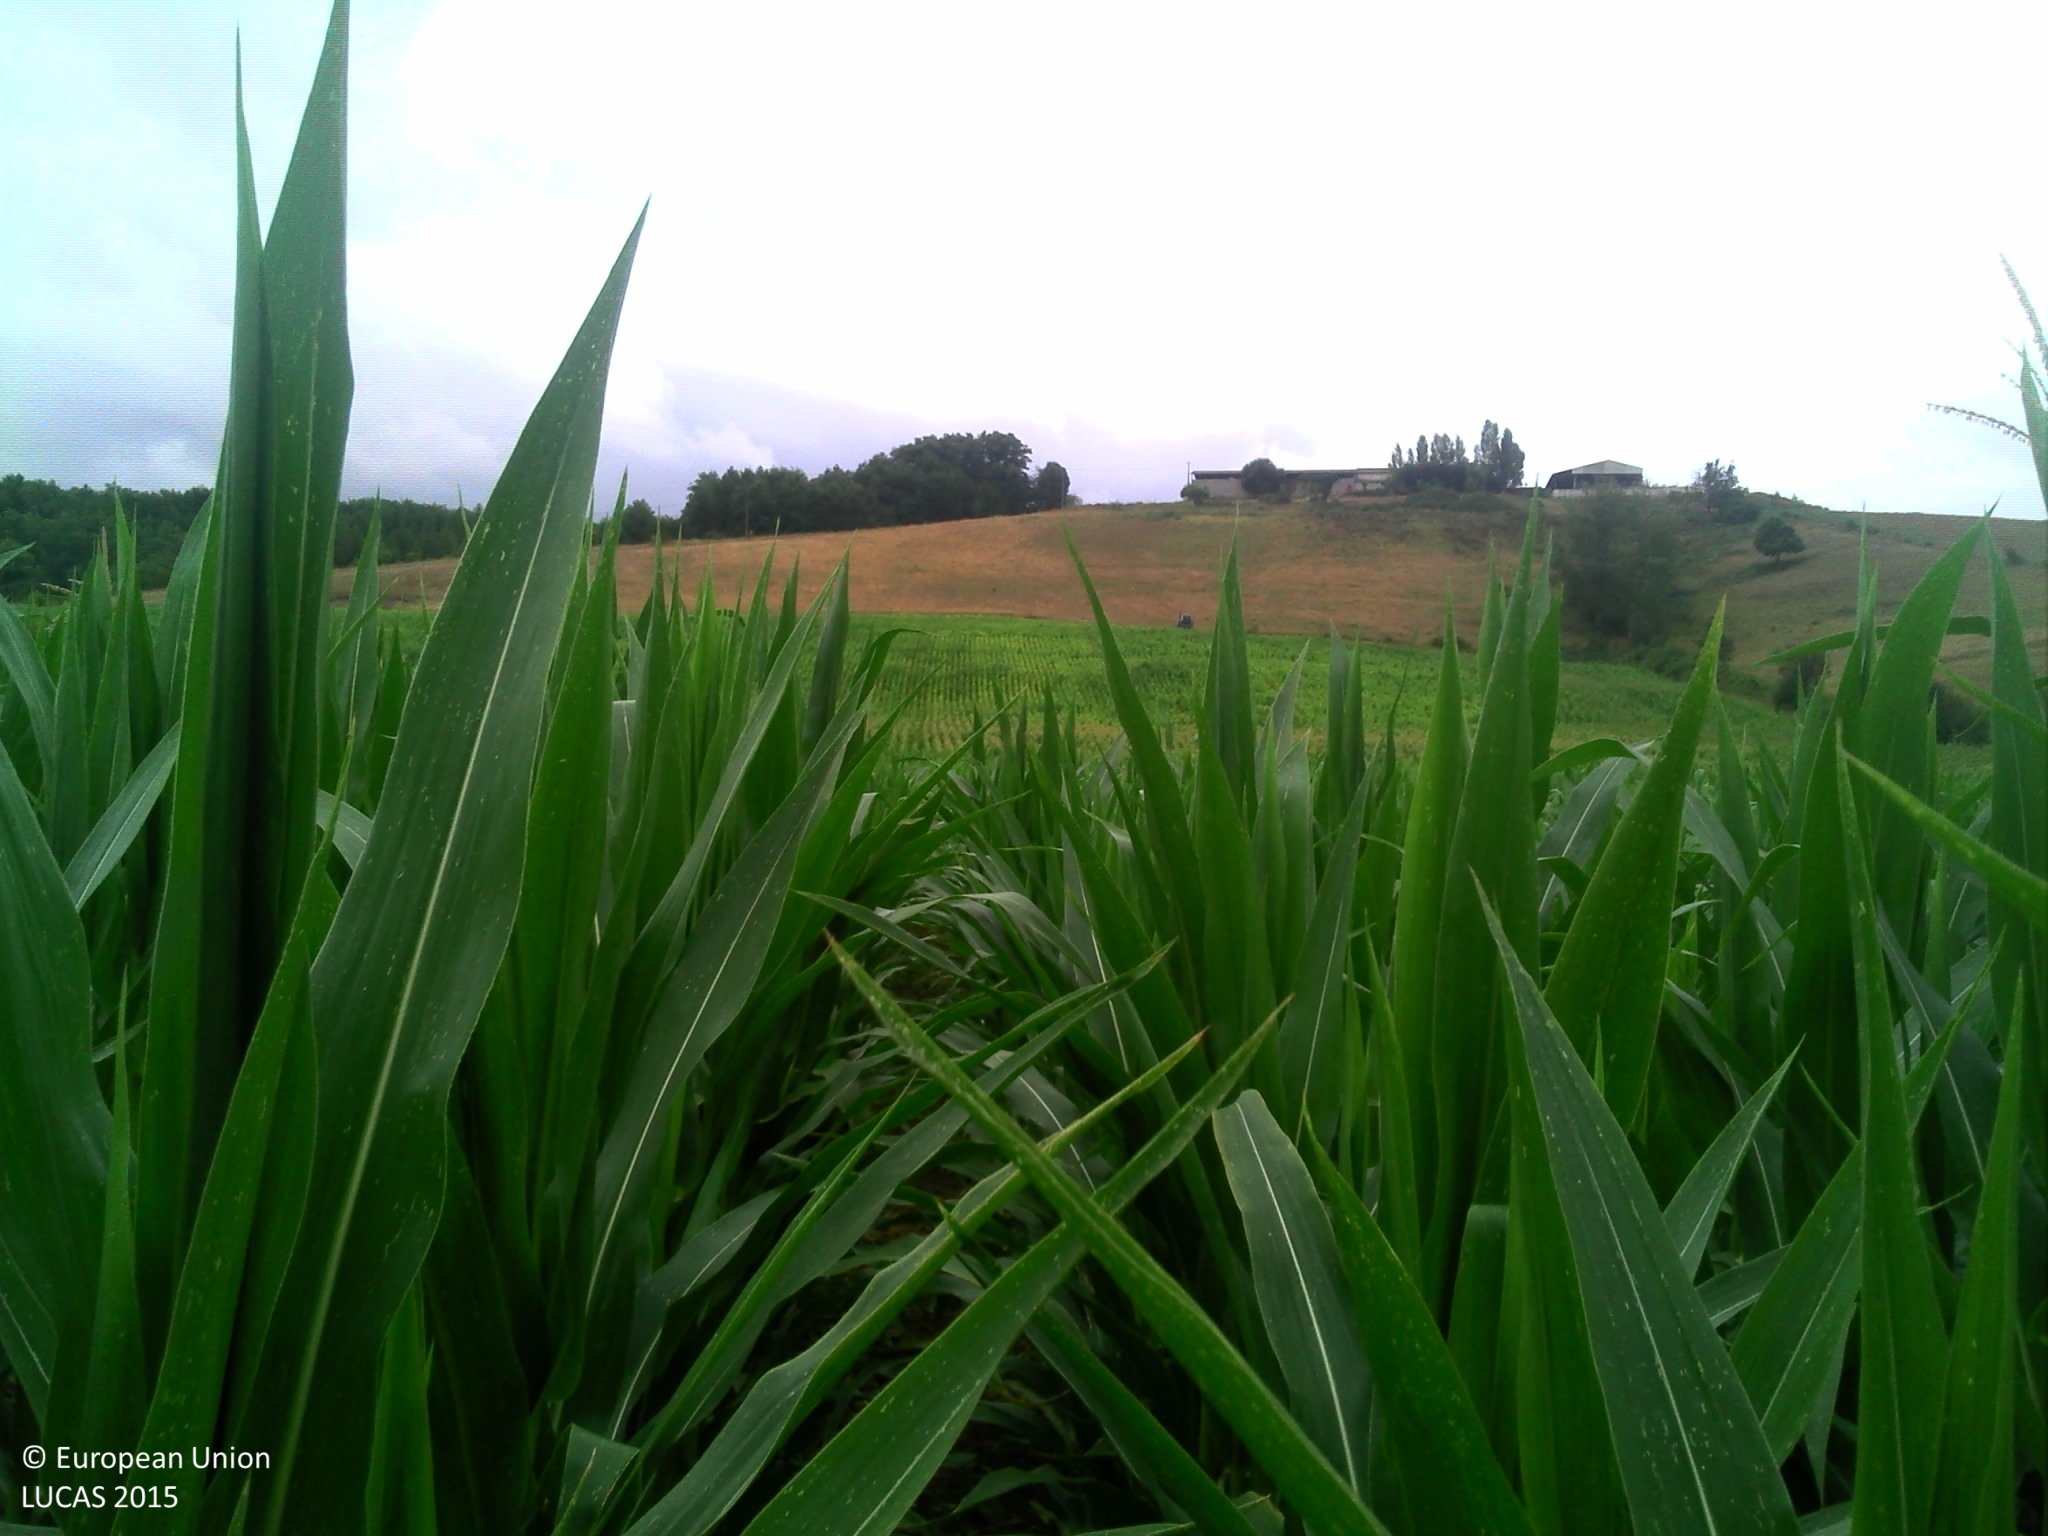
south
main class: Cropland
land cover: Maize
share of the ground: > 75 %
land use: Agriculture (excluding fallow land and kitchen gardens)
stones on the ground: < 10 %
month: July
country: FR
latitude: 43.2559
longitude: 0.8494
